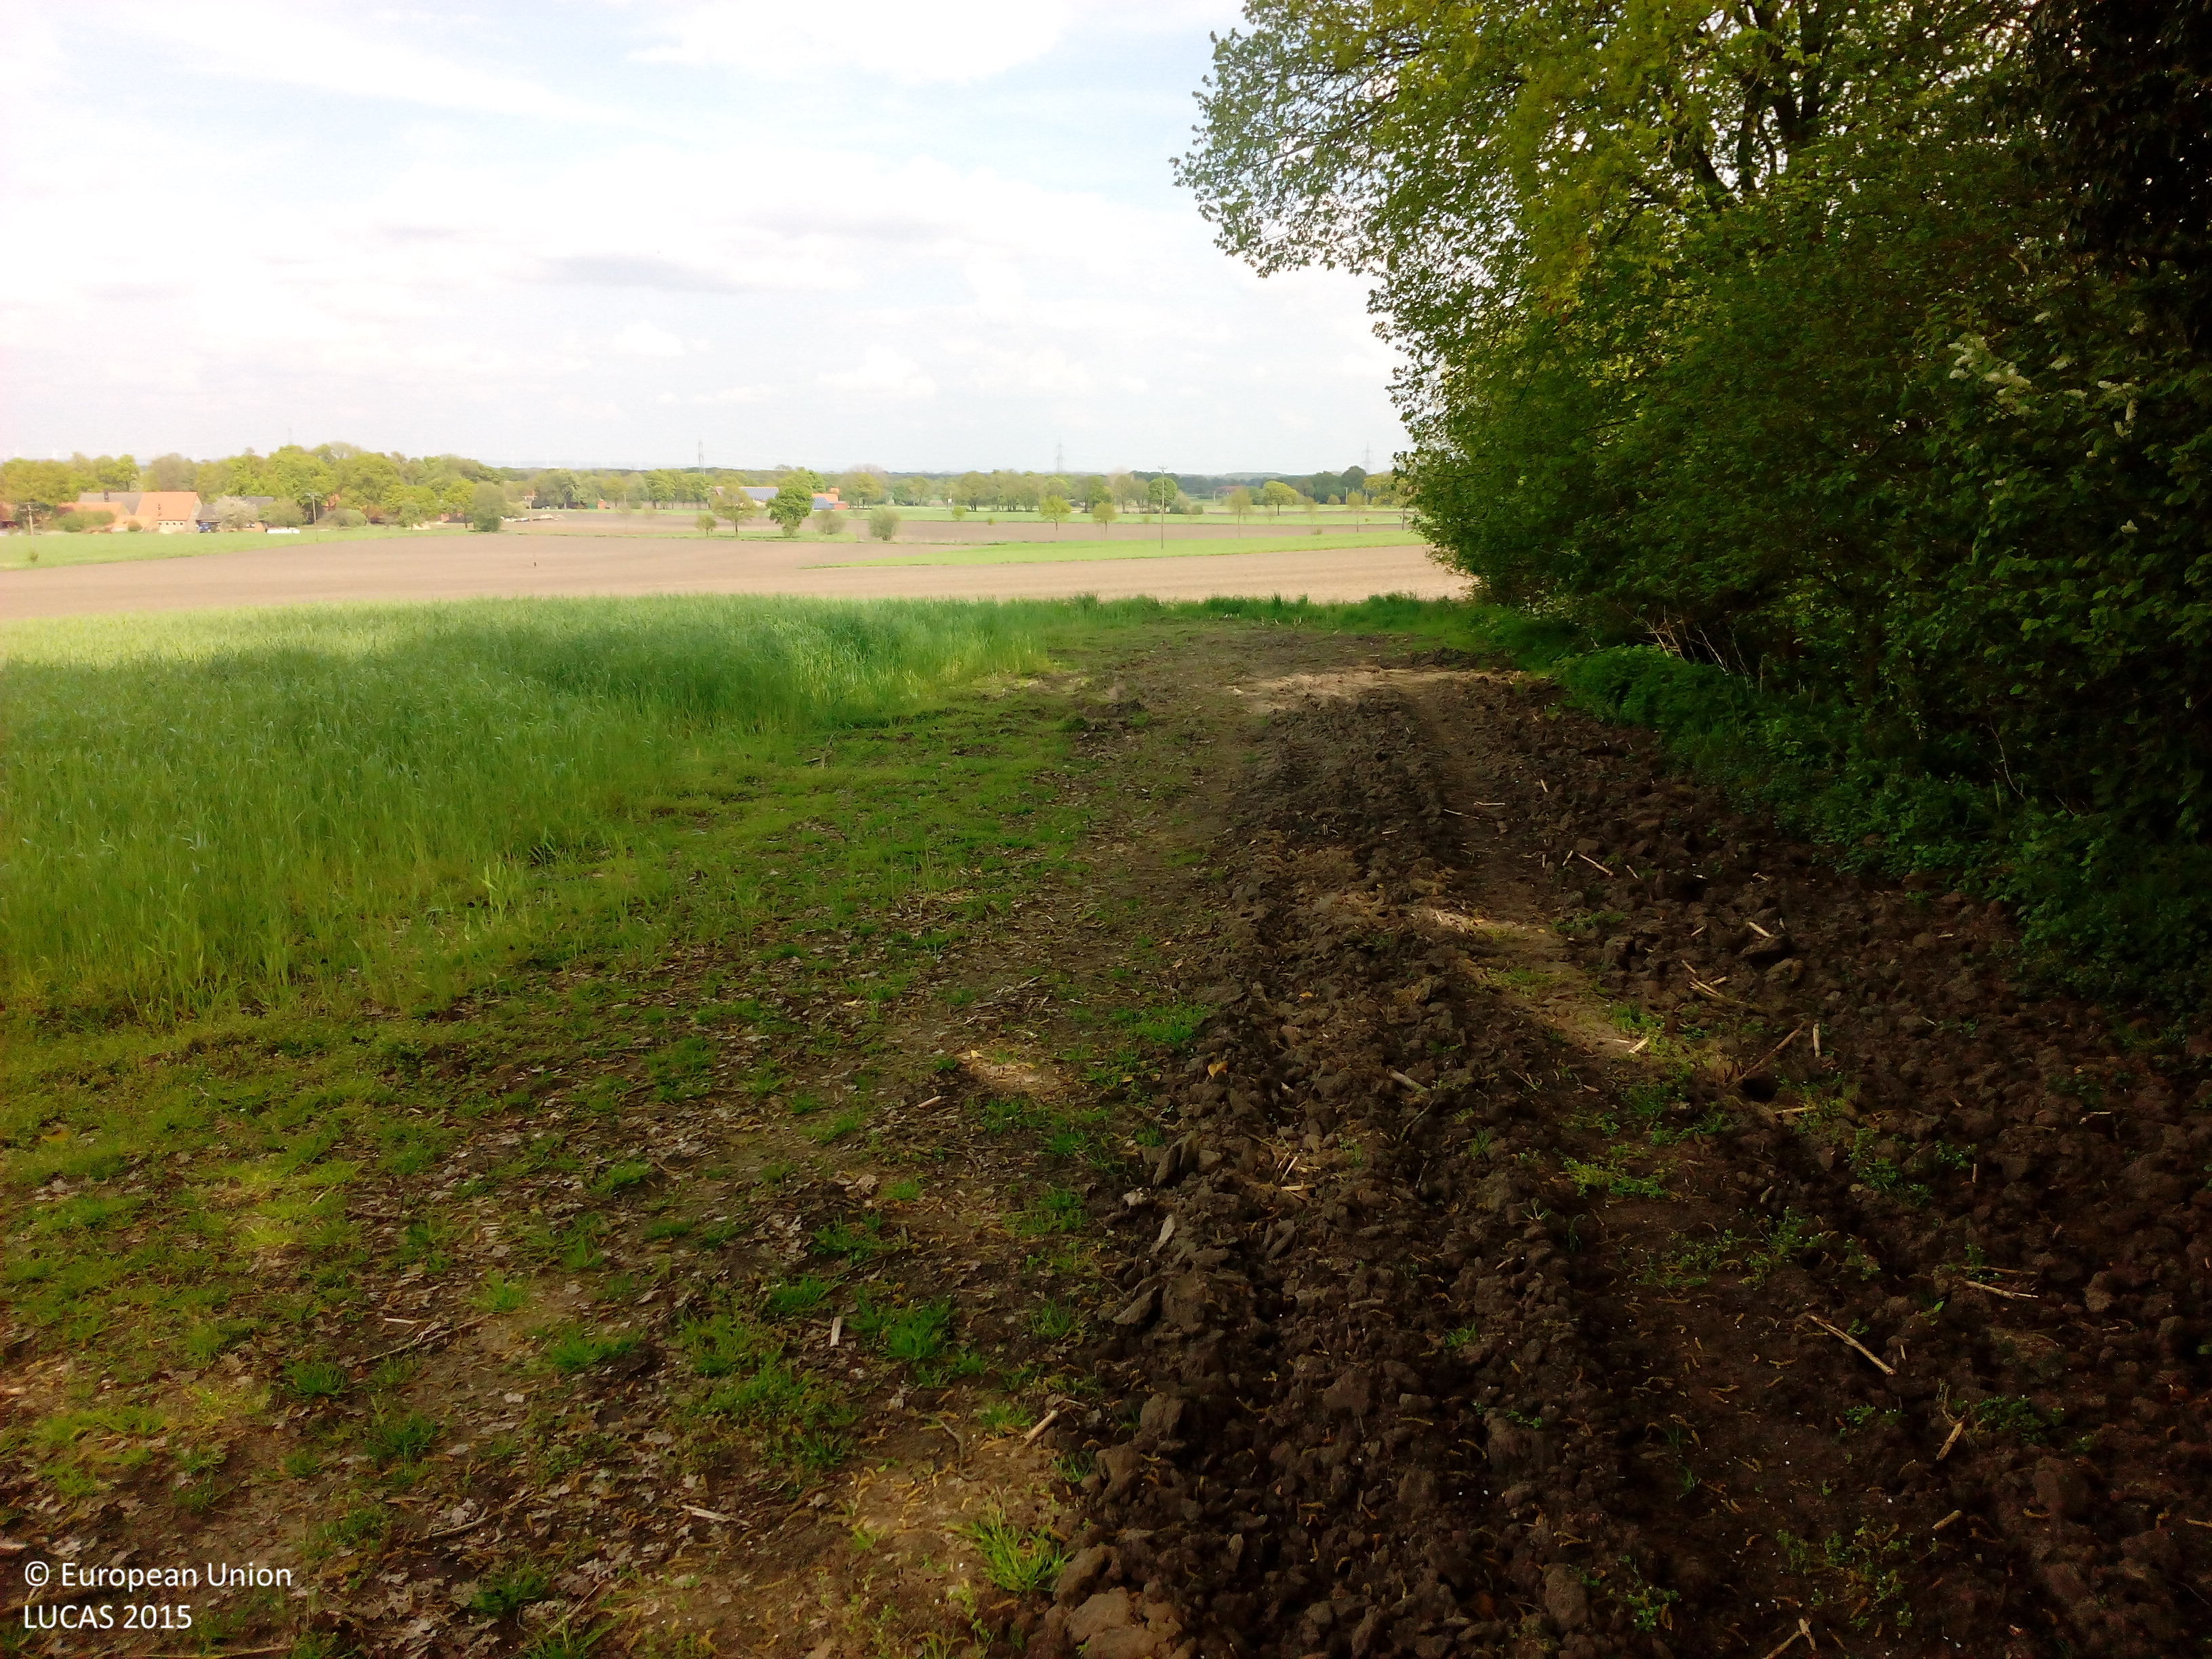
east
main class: Cropland
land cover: Maize
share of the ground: < 10 %
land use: Agriculture (excluding fallow land and kitchen gardens)
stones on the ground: < 10 %
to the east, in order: Maize; Shruby margins; Ditches and canals; Shruby margins; Maize; Grassland without tree/shrub cover
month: May
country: DE
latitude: 52.1509
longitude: 7.3842
